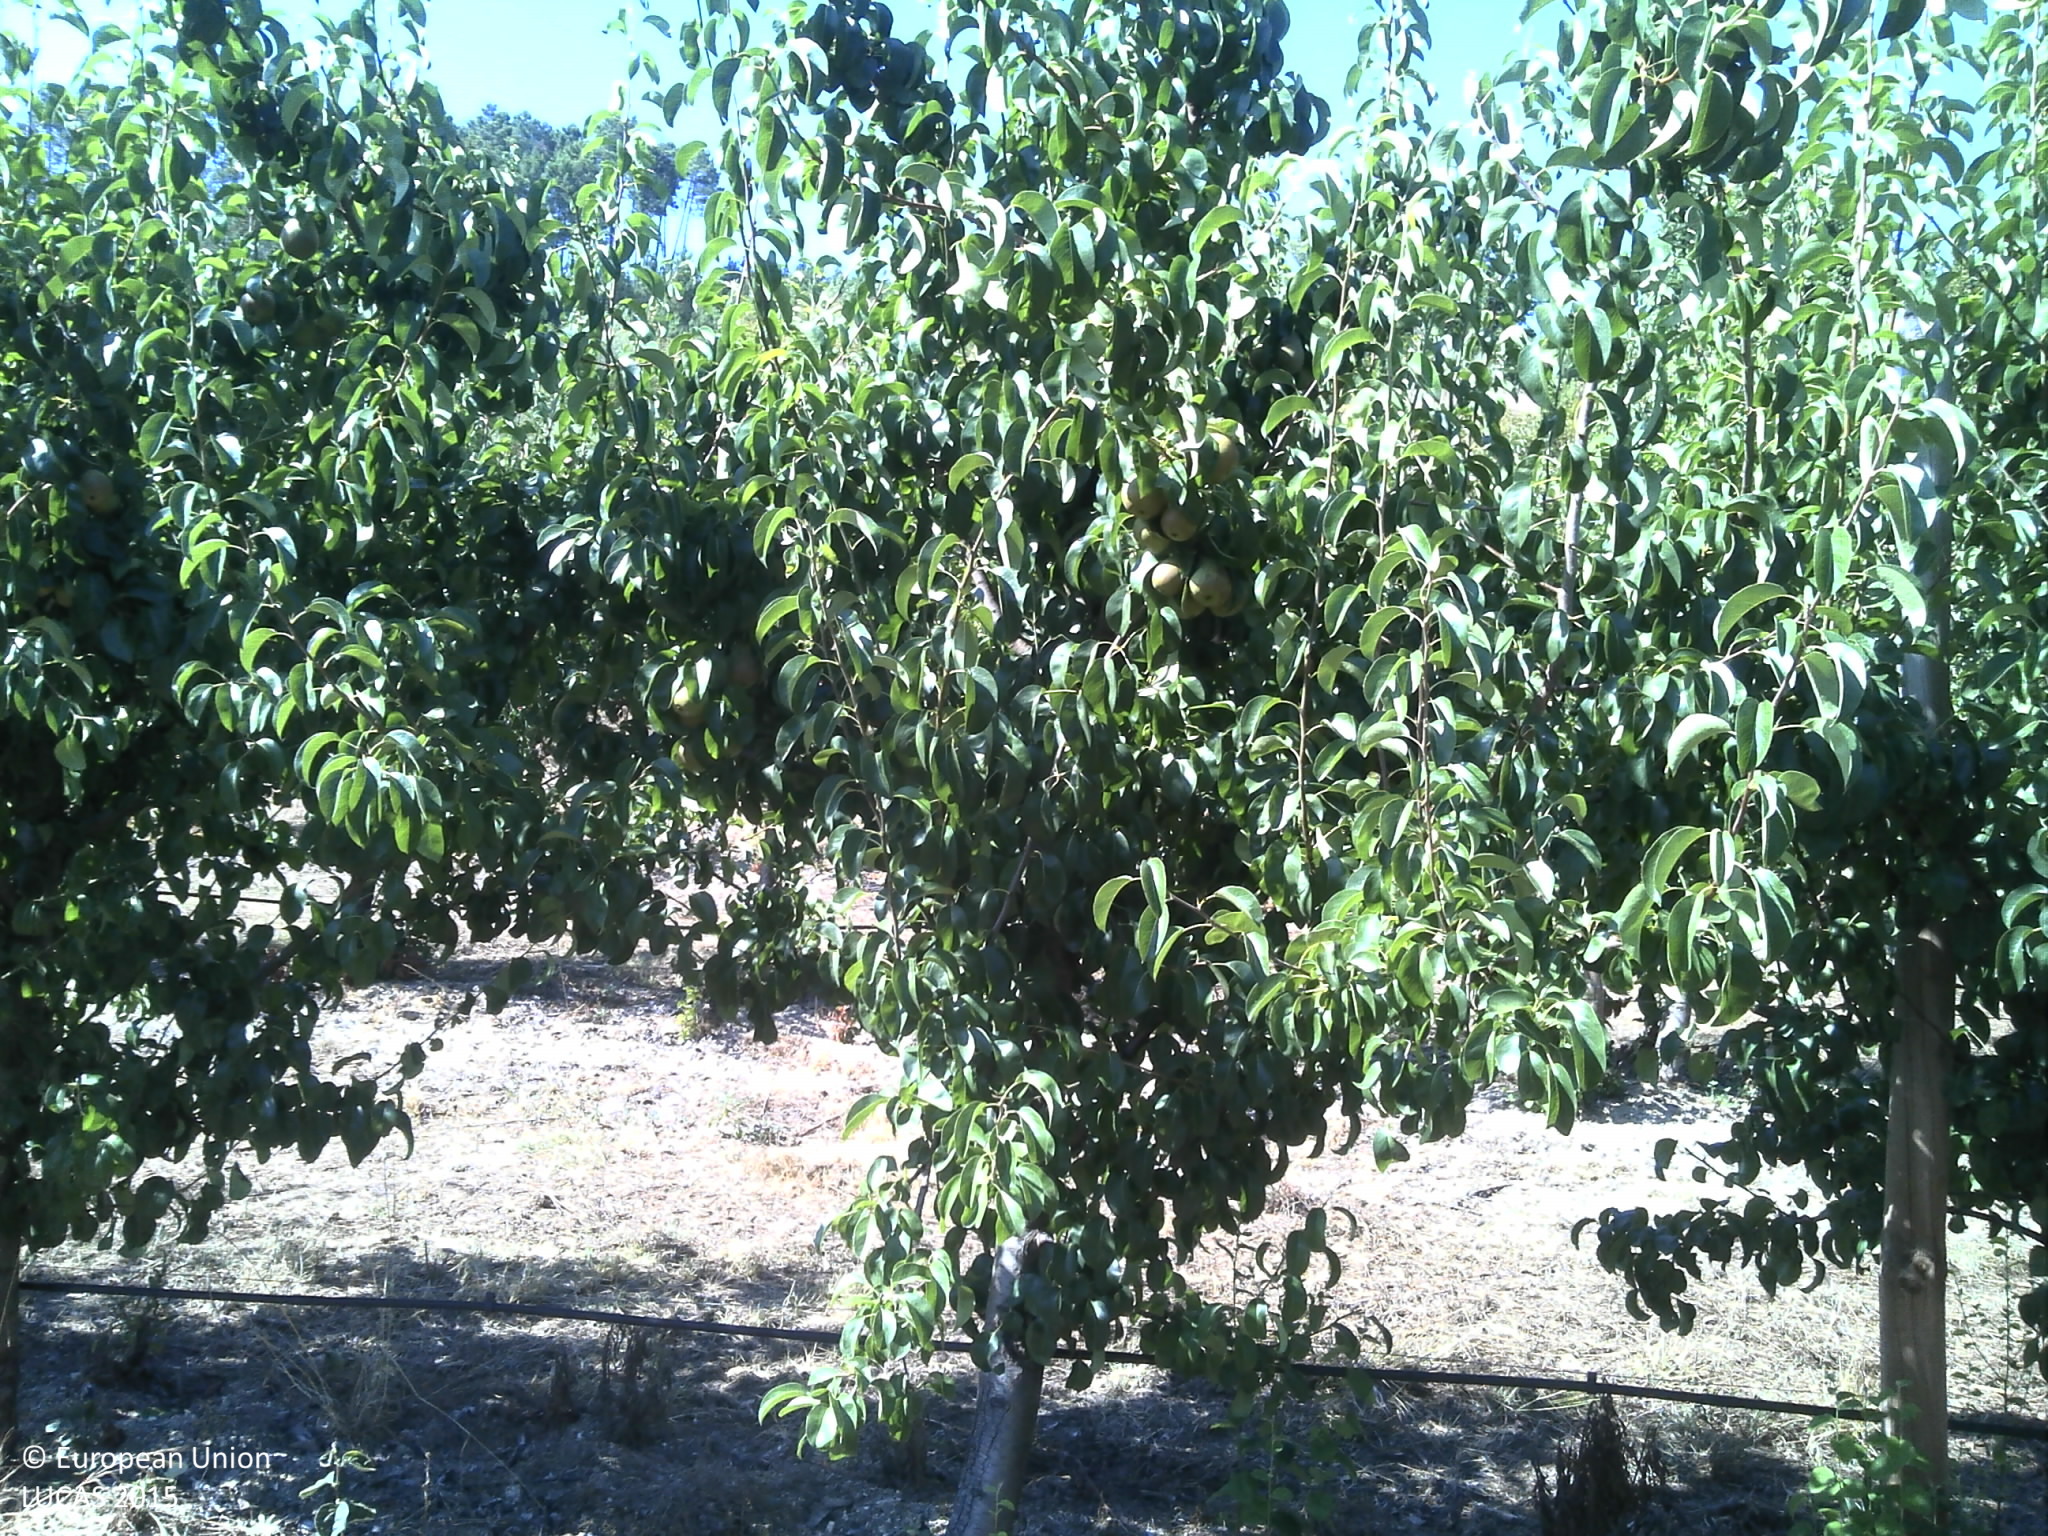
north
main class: Cropland
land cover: Pear fruit
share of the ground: 25 - 50 %
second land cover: Grassland without tree/shrub cover
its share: 25 - 50 %
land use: Agriculture (excluding fallow land and kitchen gardens)
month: July
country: PT
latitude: 40.3721
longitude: -7.9394
